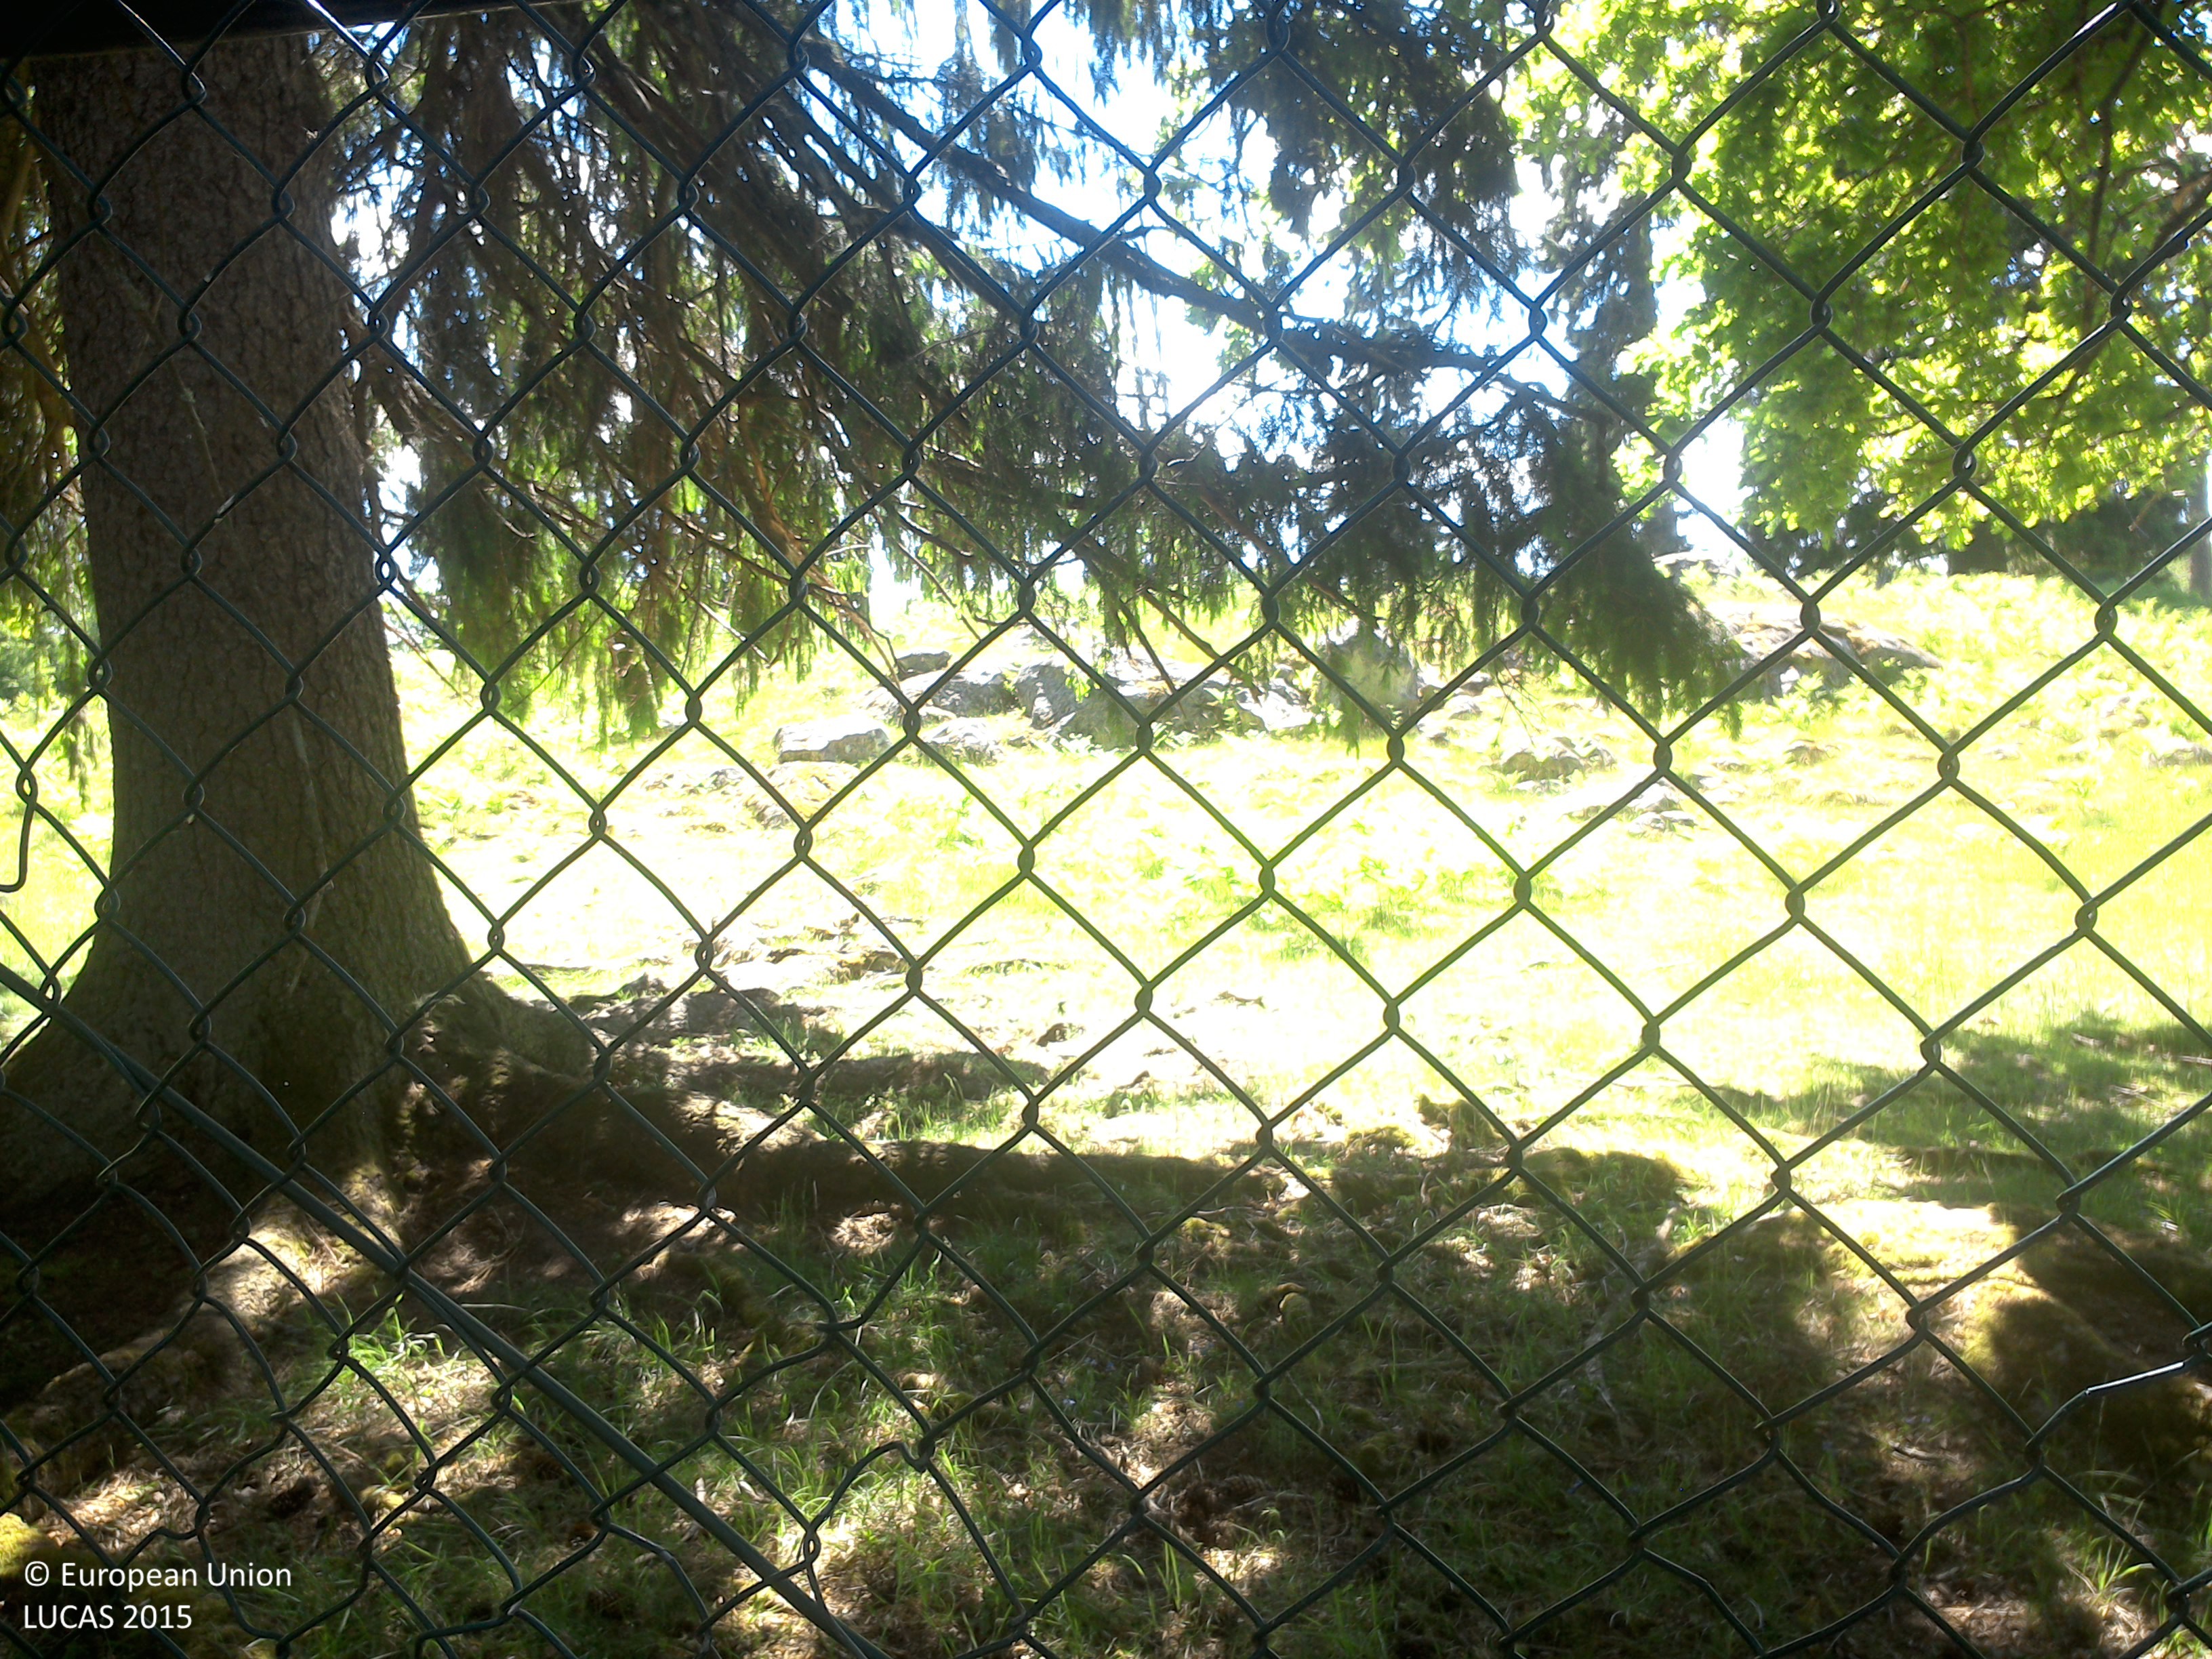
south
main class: Woodland
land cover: Spruce dominated mixed woodland
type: boreal forest
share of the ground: 50 - 75 %
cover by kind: coniferous forest trees 50 %, broadleaved forest trees 25 %, herbaceous plants 25 %
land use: Forestry
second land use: Amenities, museums, leisure
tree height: > 5 m
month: June
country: SE
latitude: 58.2773
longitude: 15.7415
